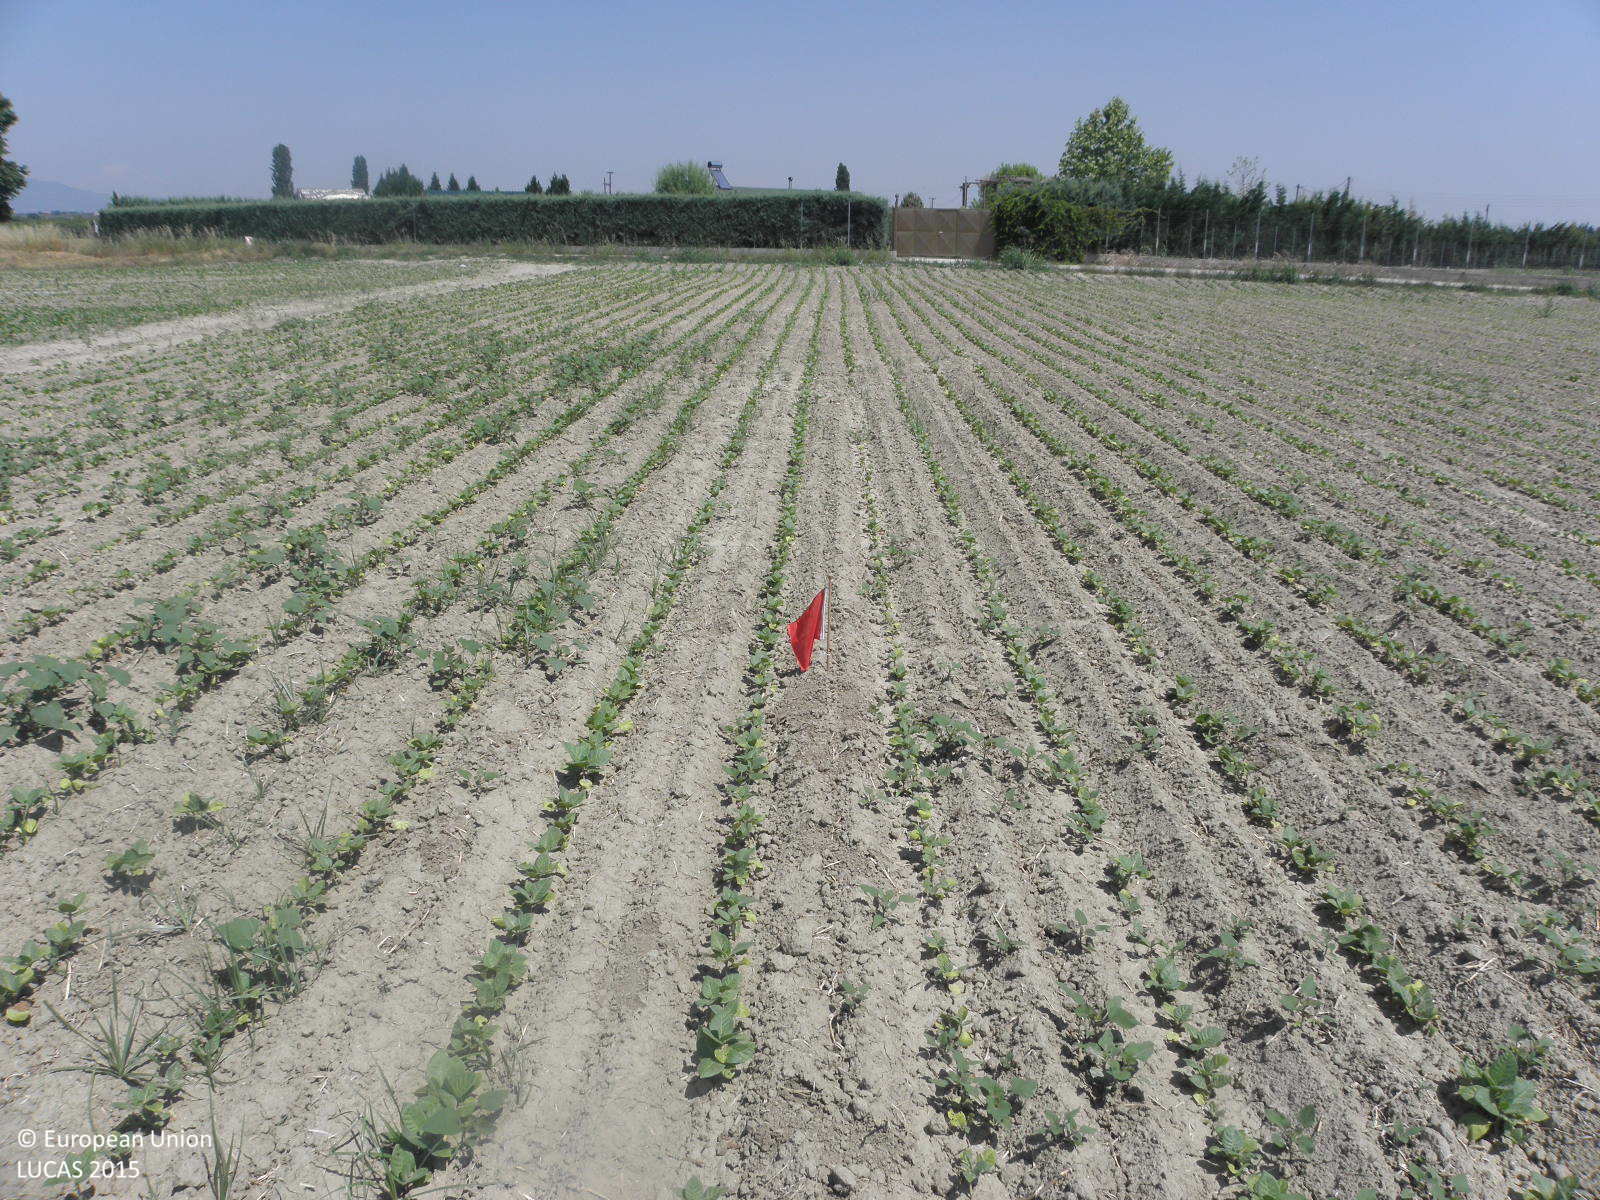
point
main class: Cropland
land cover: Tobacco
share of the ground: < 10 %
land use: Agriculture (excluding fallow land and kitchen gardens)
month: June
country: GR
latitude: 40.2127
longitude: 22.5111
